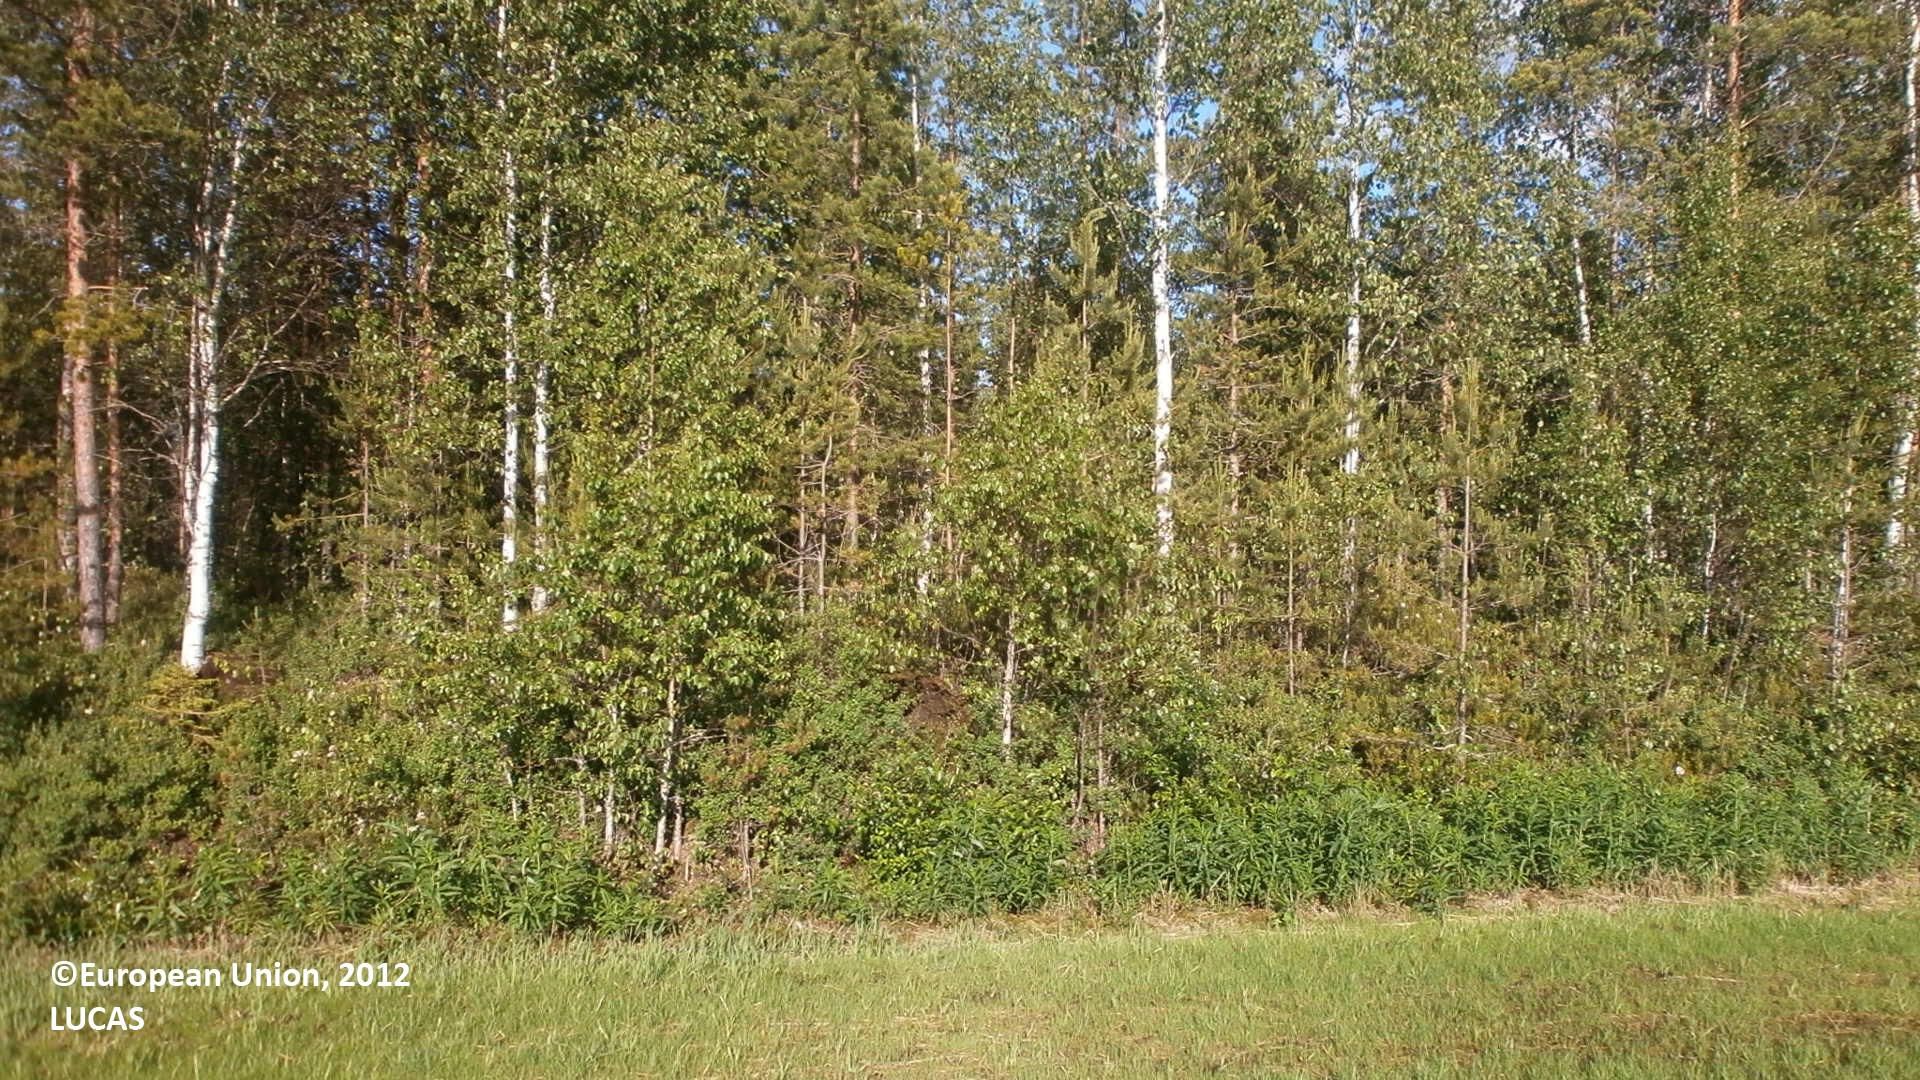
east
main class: Cropland
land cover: Temporary grasslands
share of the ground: 25 - 50 %
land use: Agriculture (excluding fallow land and kitchen gardens)
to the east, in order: Temporary grasslands; Shruby margins; Ditches and canals; Pine dominated mixed woodland; Ditches and canals; Pine dominated mixed woodland; Ditches and canals; Pine dominated mixed woodland; Pine dominated coniferous woodland; Peatbogs
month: June
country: FI
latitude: 64.4350
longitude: 25.0132
